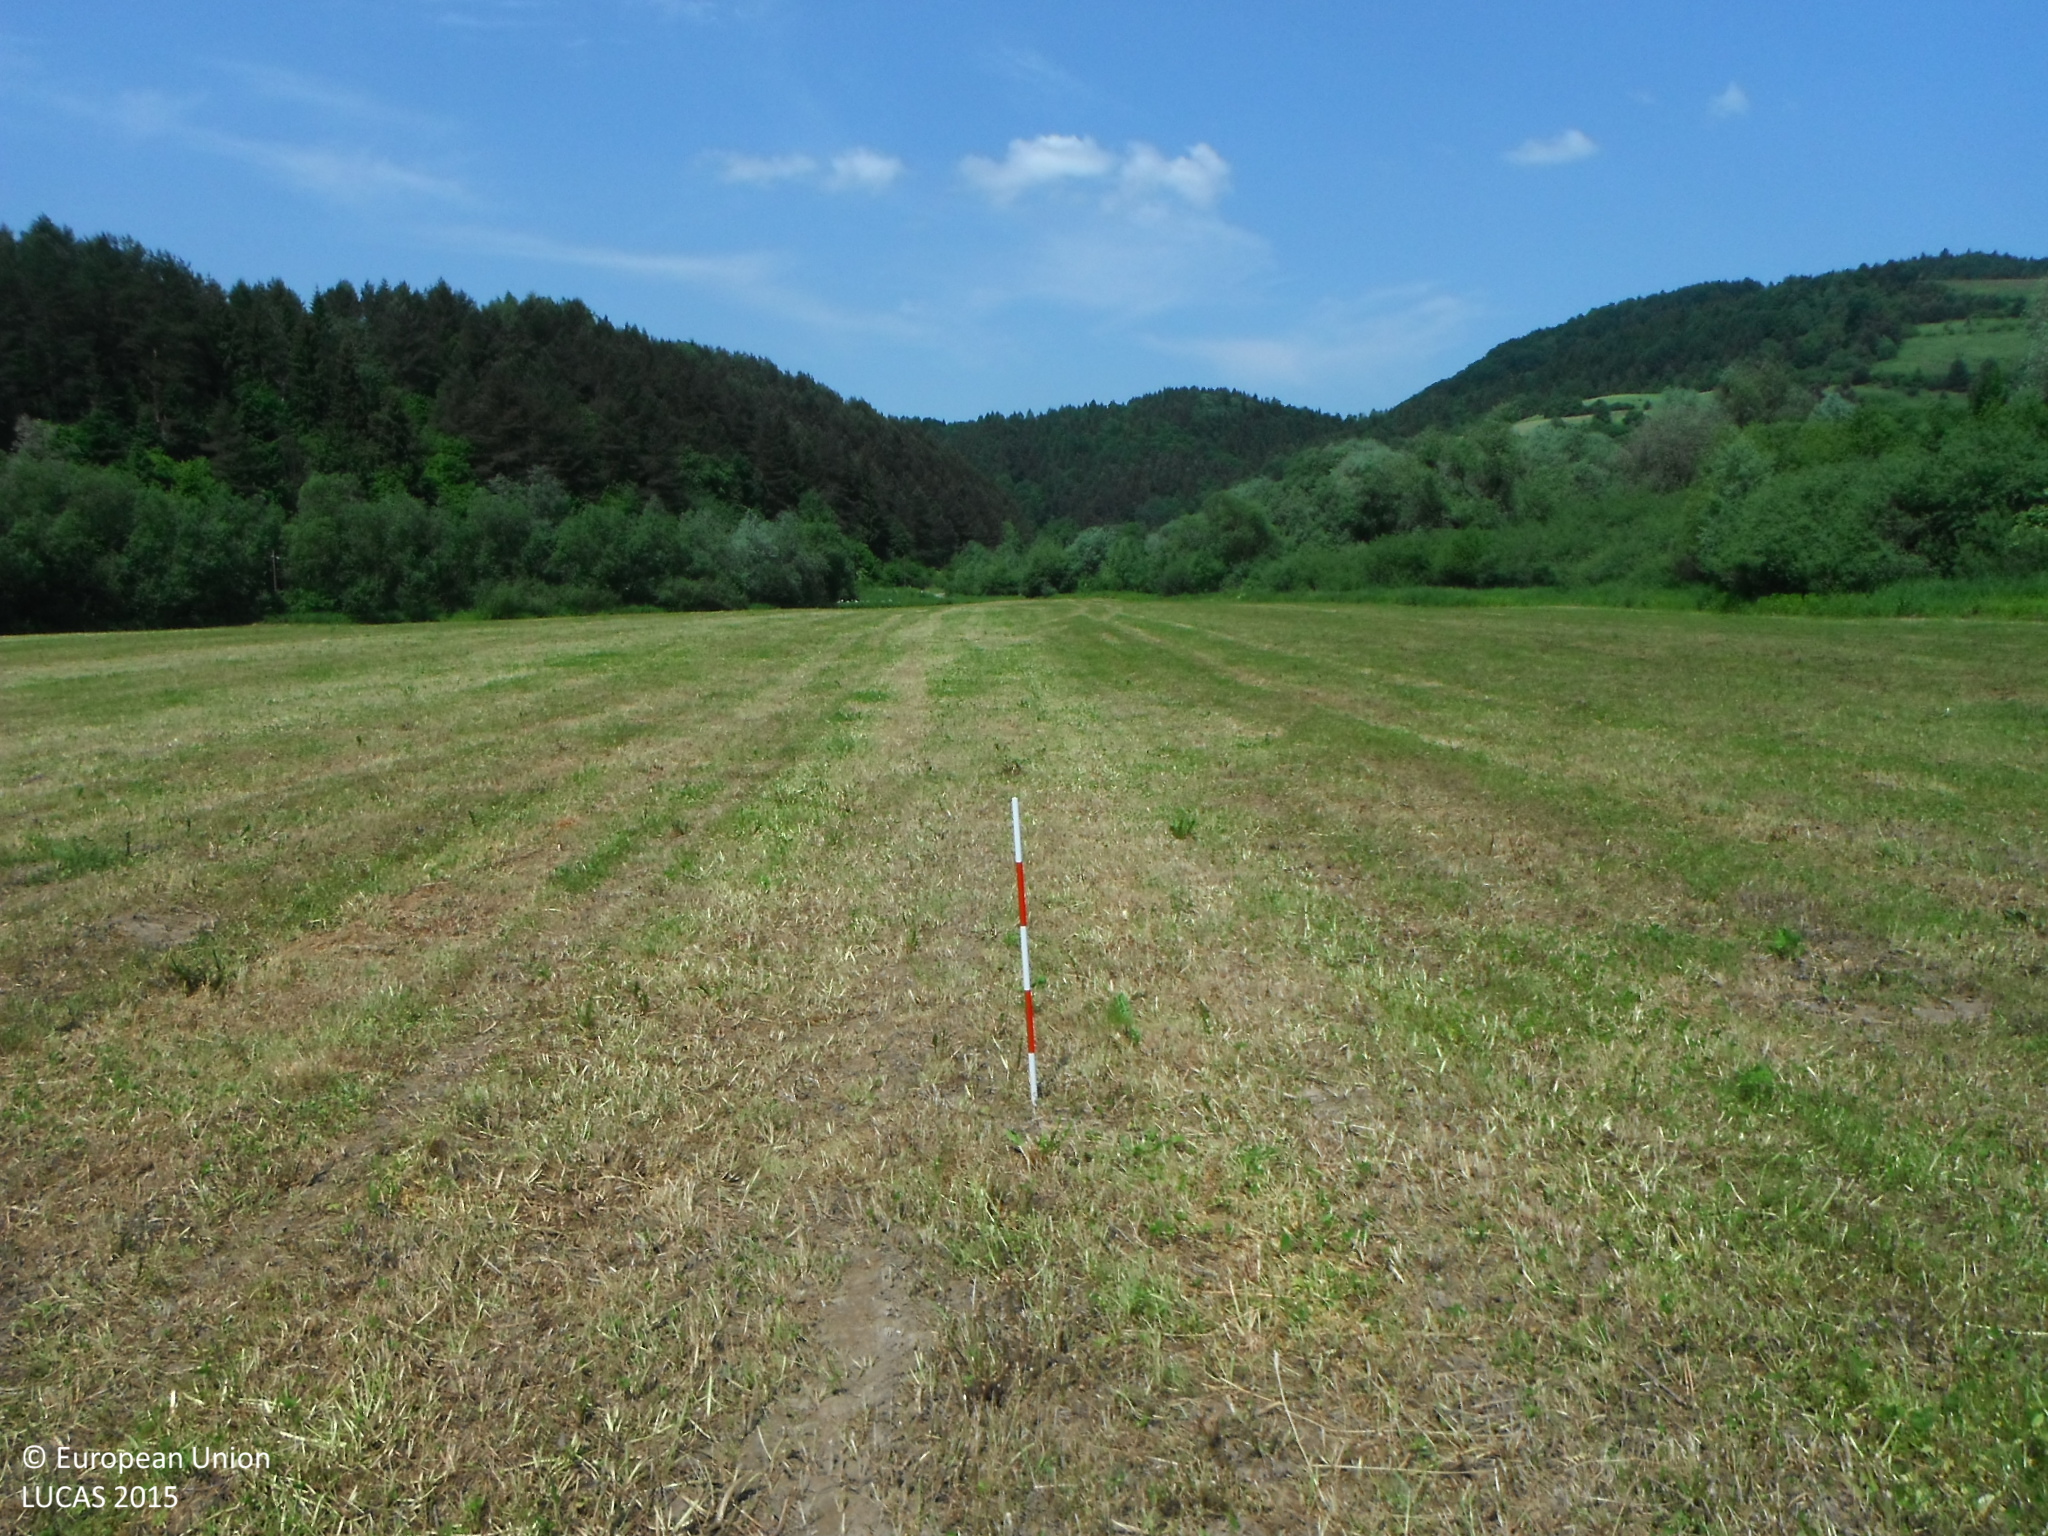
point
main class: Grassland
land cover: Grassland without tree/shrub cover
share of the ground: > 75 %
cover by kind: herbaceous plants 100 %
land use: Agriculture (excluding fallow land and kitchen gardens)
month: June
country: SK
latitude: 49.3413
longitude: 20.8171
